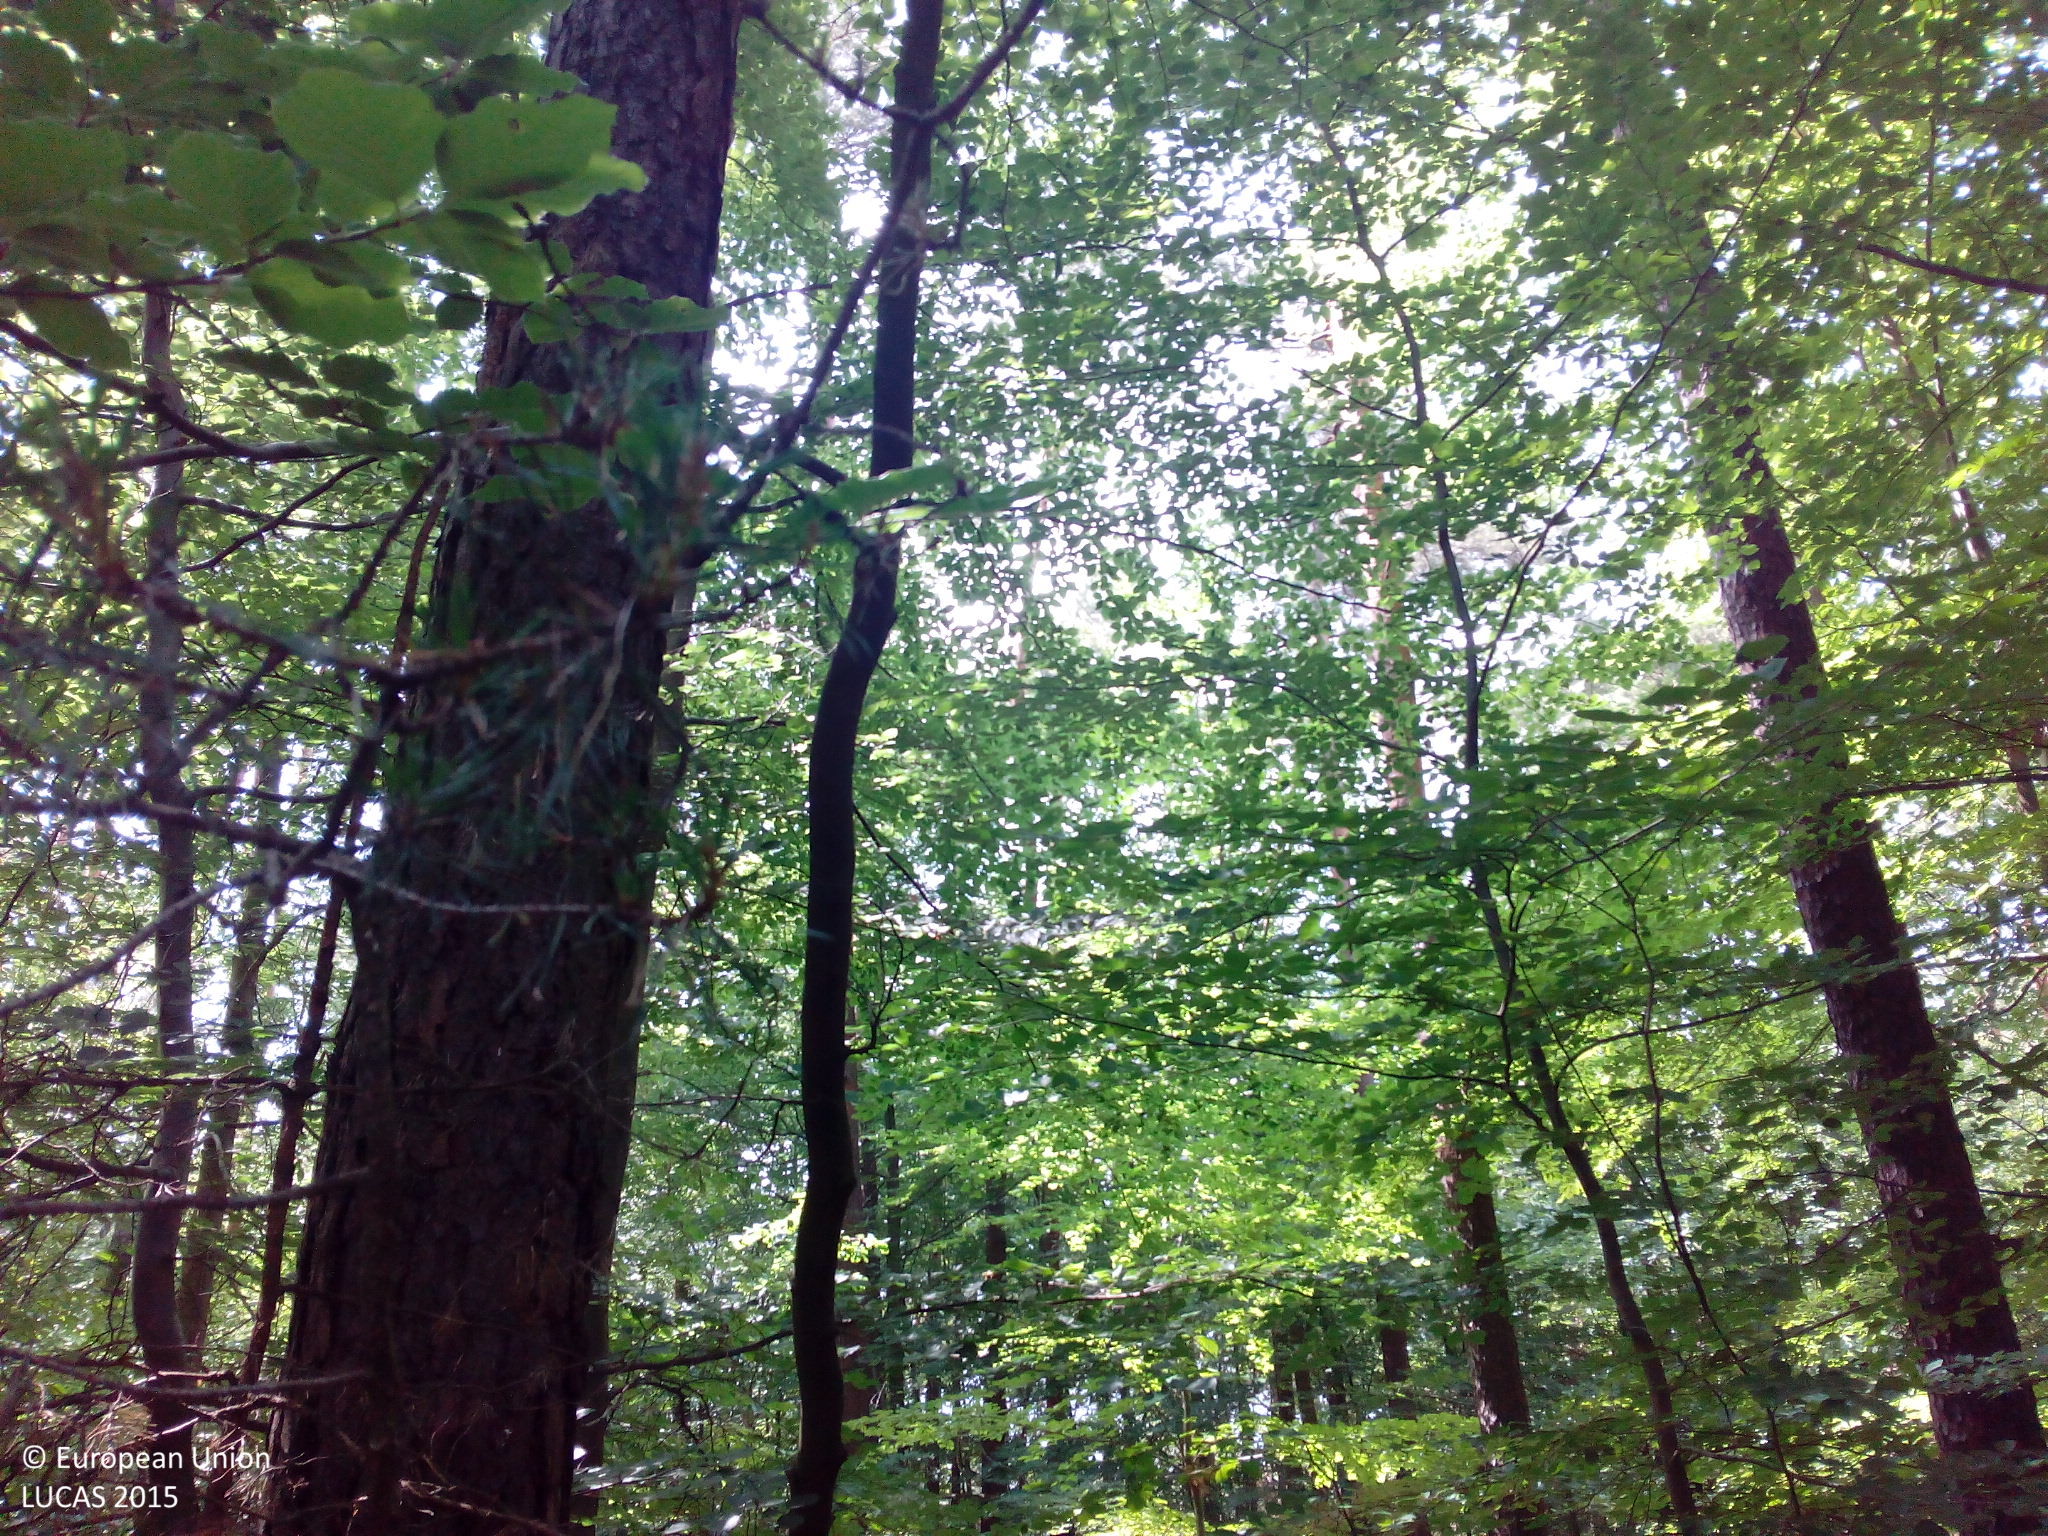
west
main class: Woodland
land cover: Pine dominated mixed woodland
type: hemiboreal forest and nemoral coniferous forest and mixed broadleaved-coniferous forest
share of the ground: > 75 %
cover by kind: broadleaved forest trees 70 %, coniferous forest trees 25 %, unconsolidated bare surface 5 %
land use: Forestry
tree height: > 5 m
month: June
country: DE
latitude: 49.5380
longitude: 8.0521
